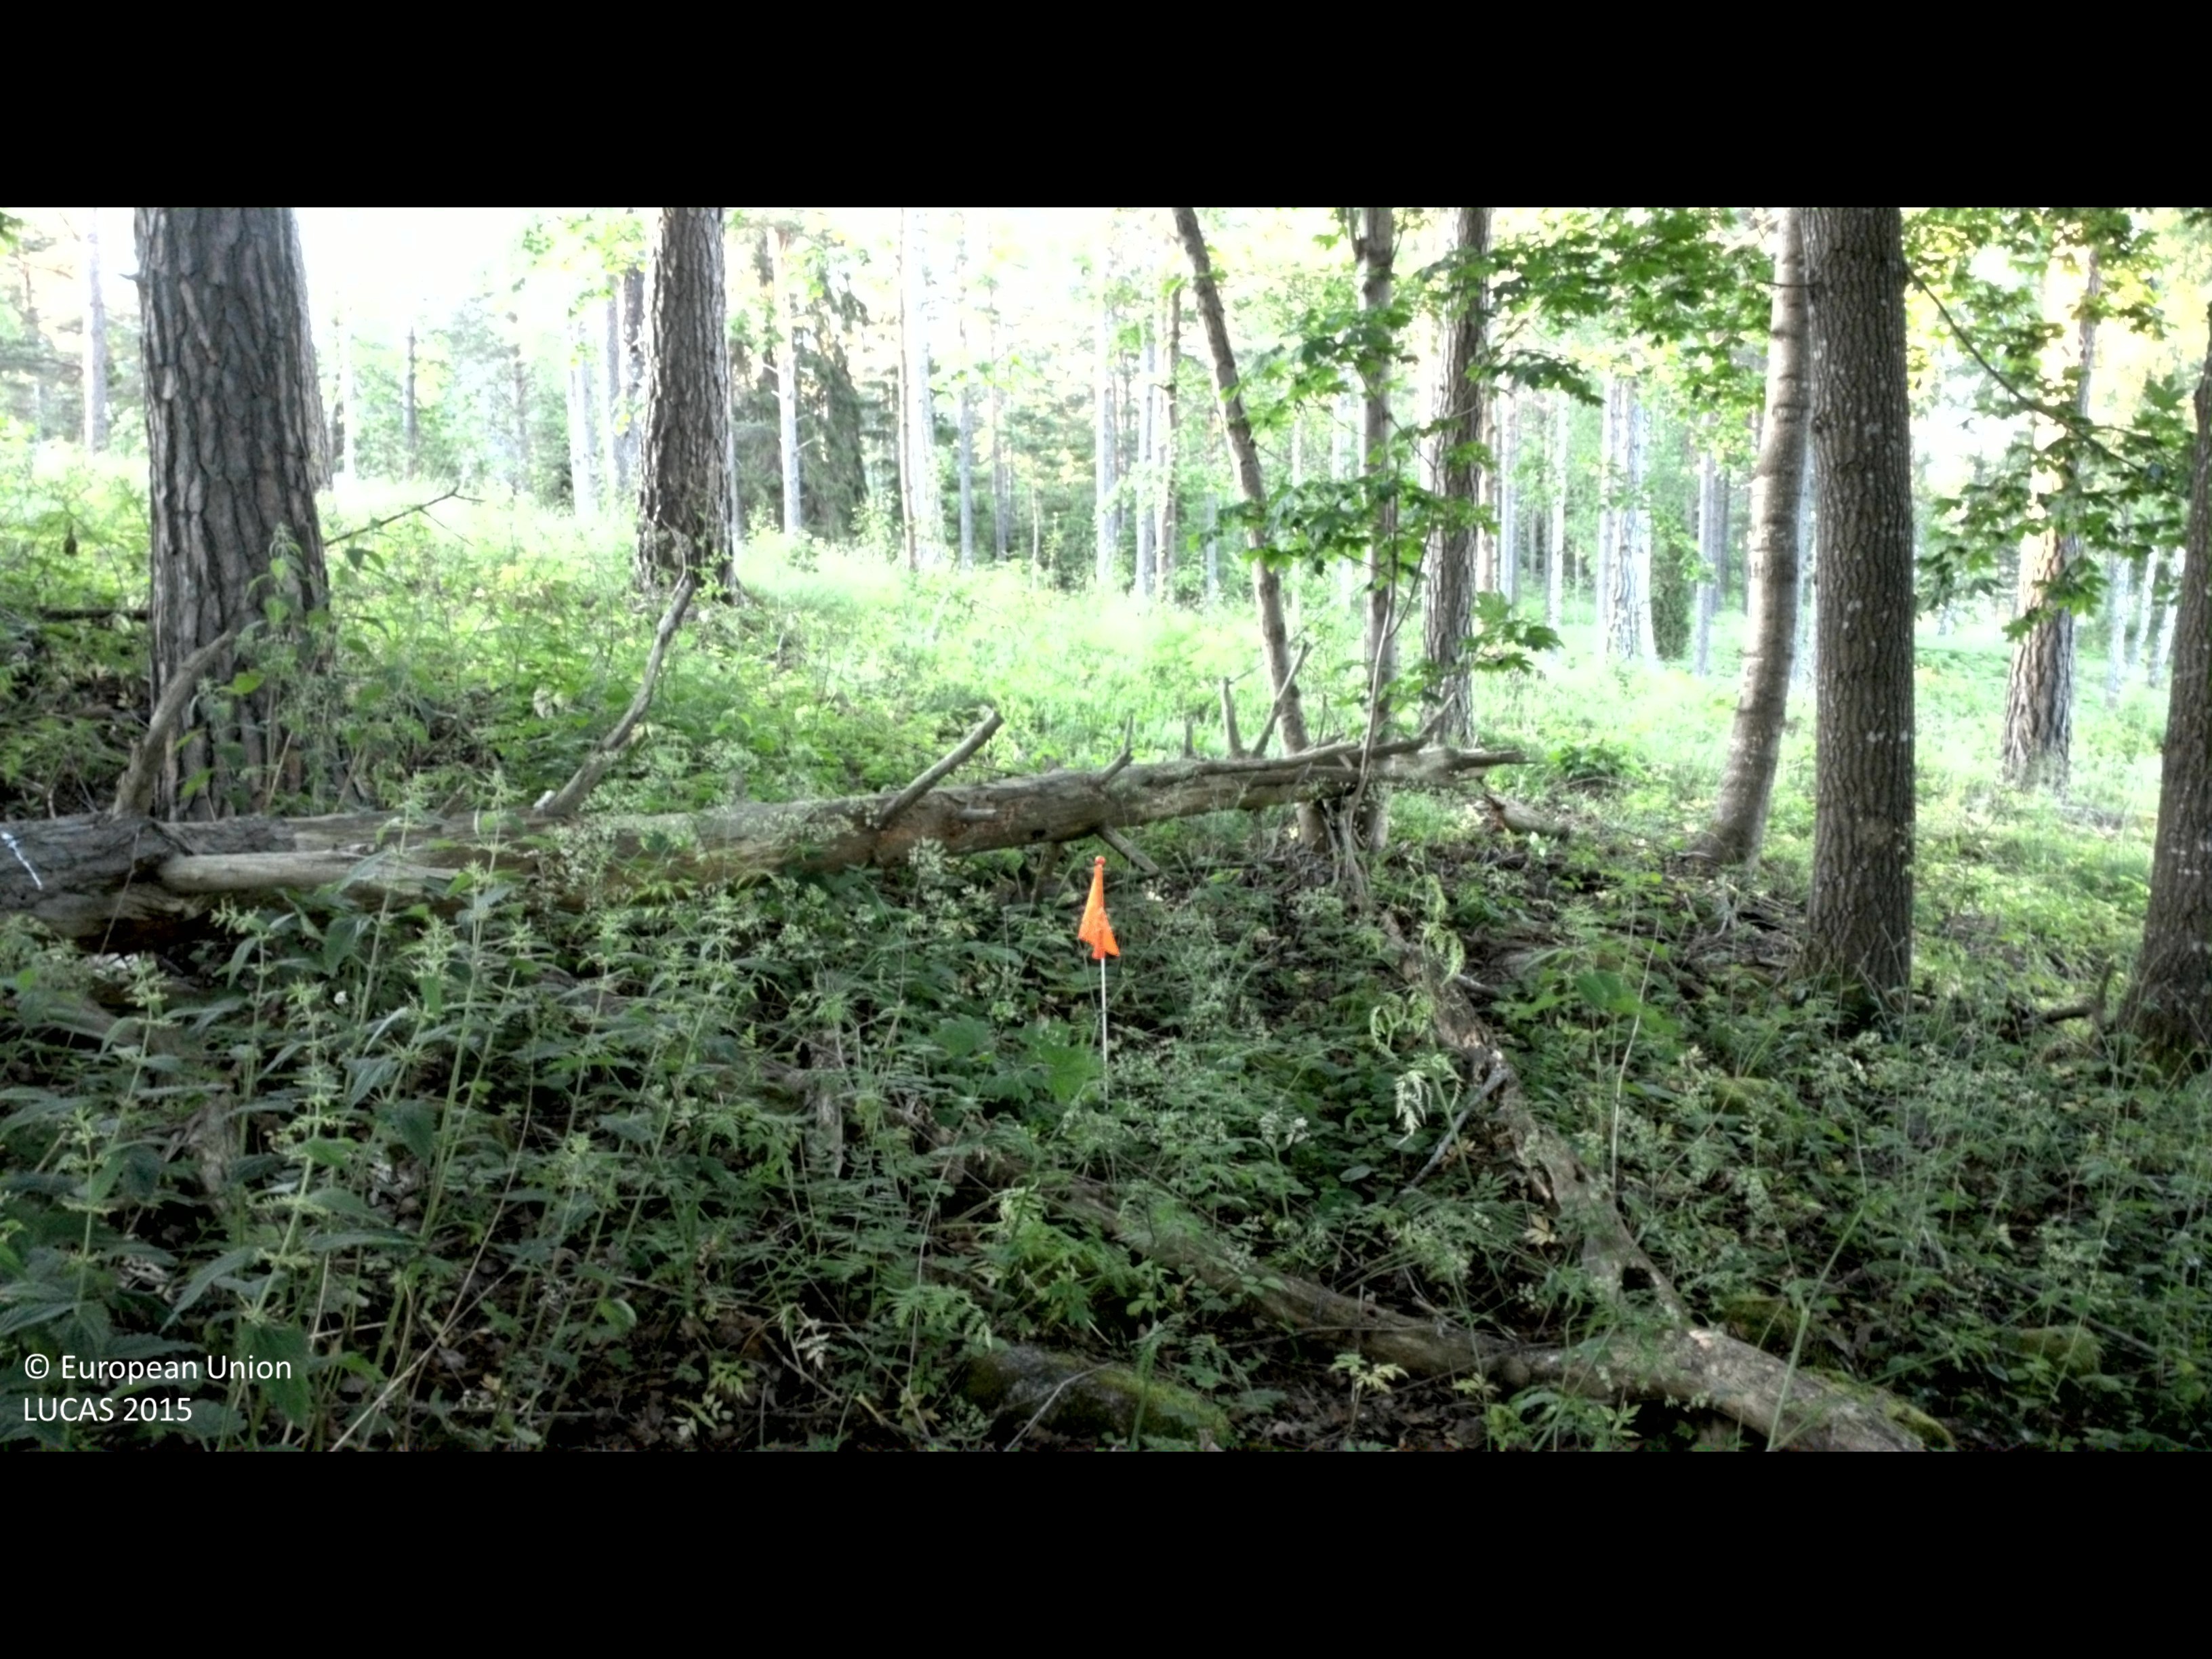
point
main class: Woodland
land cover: Other mixed woodland
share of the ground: > 75 %
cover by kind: broadleaved forest trees 65 %, coniferous forest trees 25 %, shrubs 5 %, herbaceous plants 5 %
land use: Forestry
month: June
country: SE
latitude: 58.1294
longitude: 16.6031
